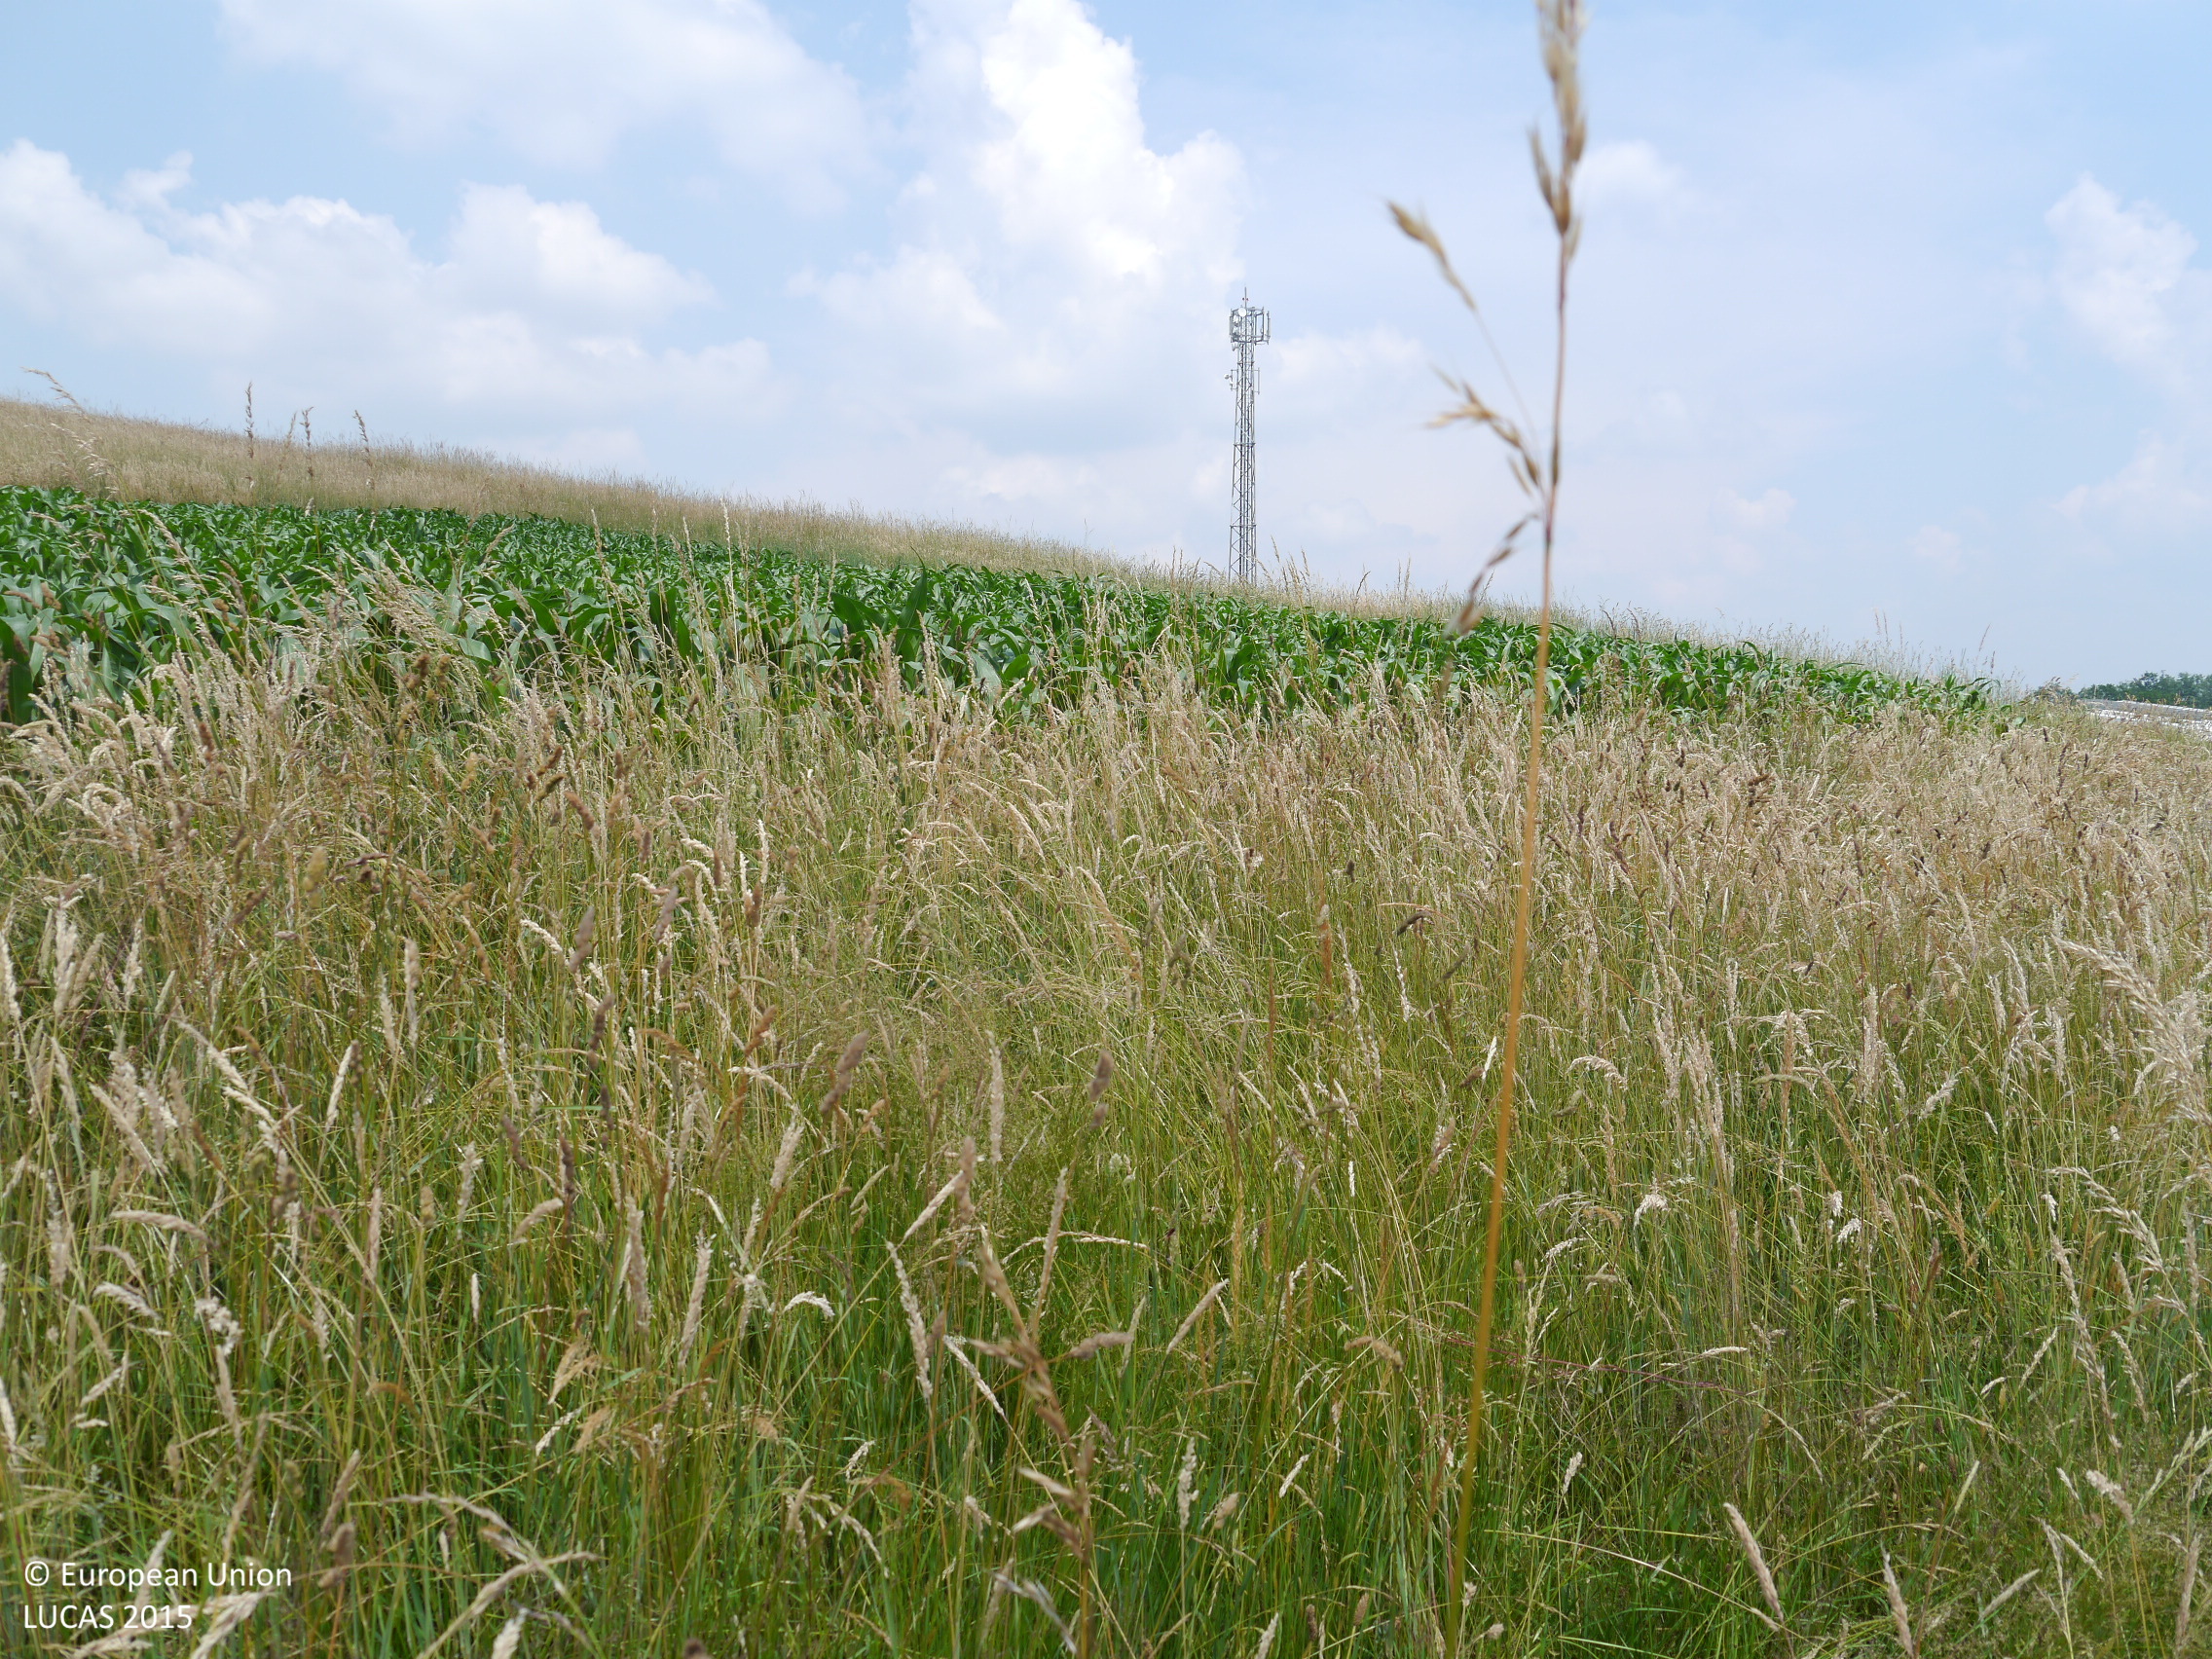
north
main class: Grassland
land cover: Grassland with sparse tree/shrub cover
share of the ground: > 75 %
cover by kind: herbaceous plants 95 %, broadleaved forest trees 5 %
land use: Agriculture (excluding fallow land and kitchen gardens)
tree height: < 5 m
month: June
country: AT
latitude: 46.8715
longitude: 15.2601
